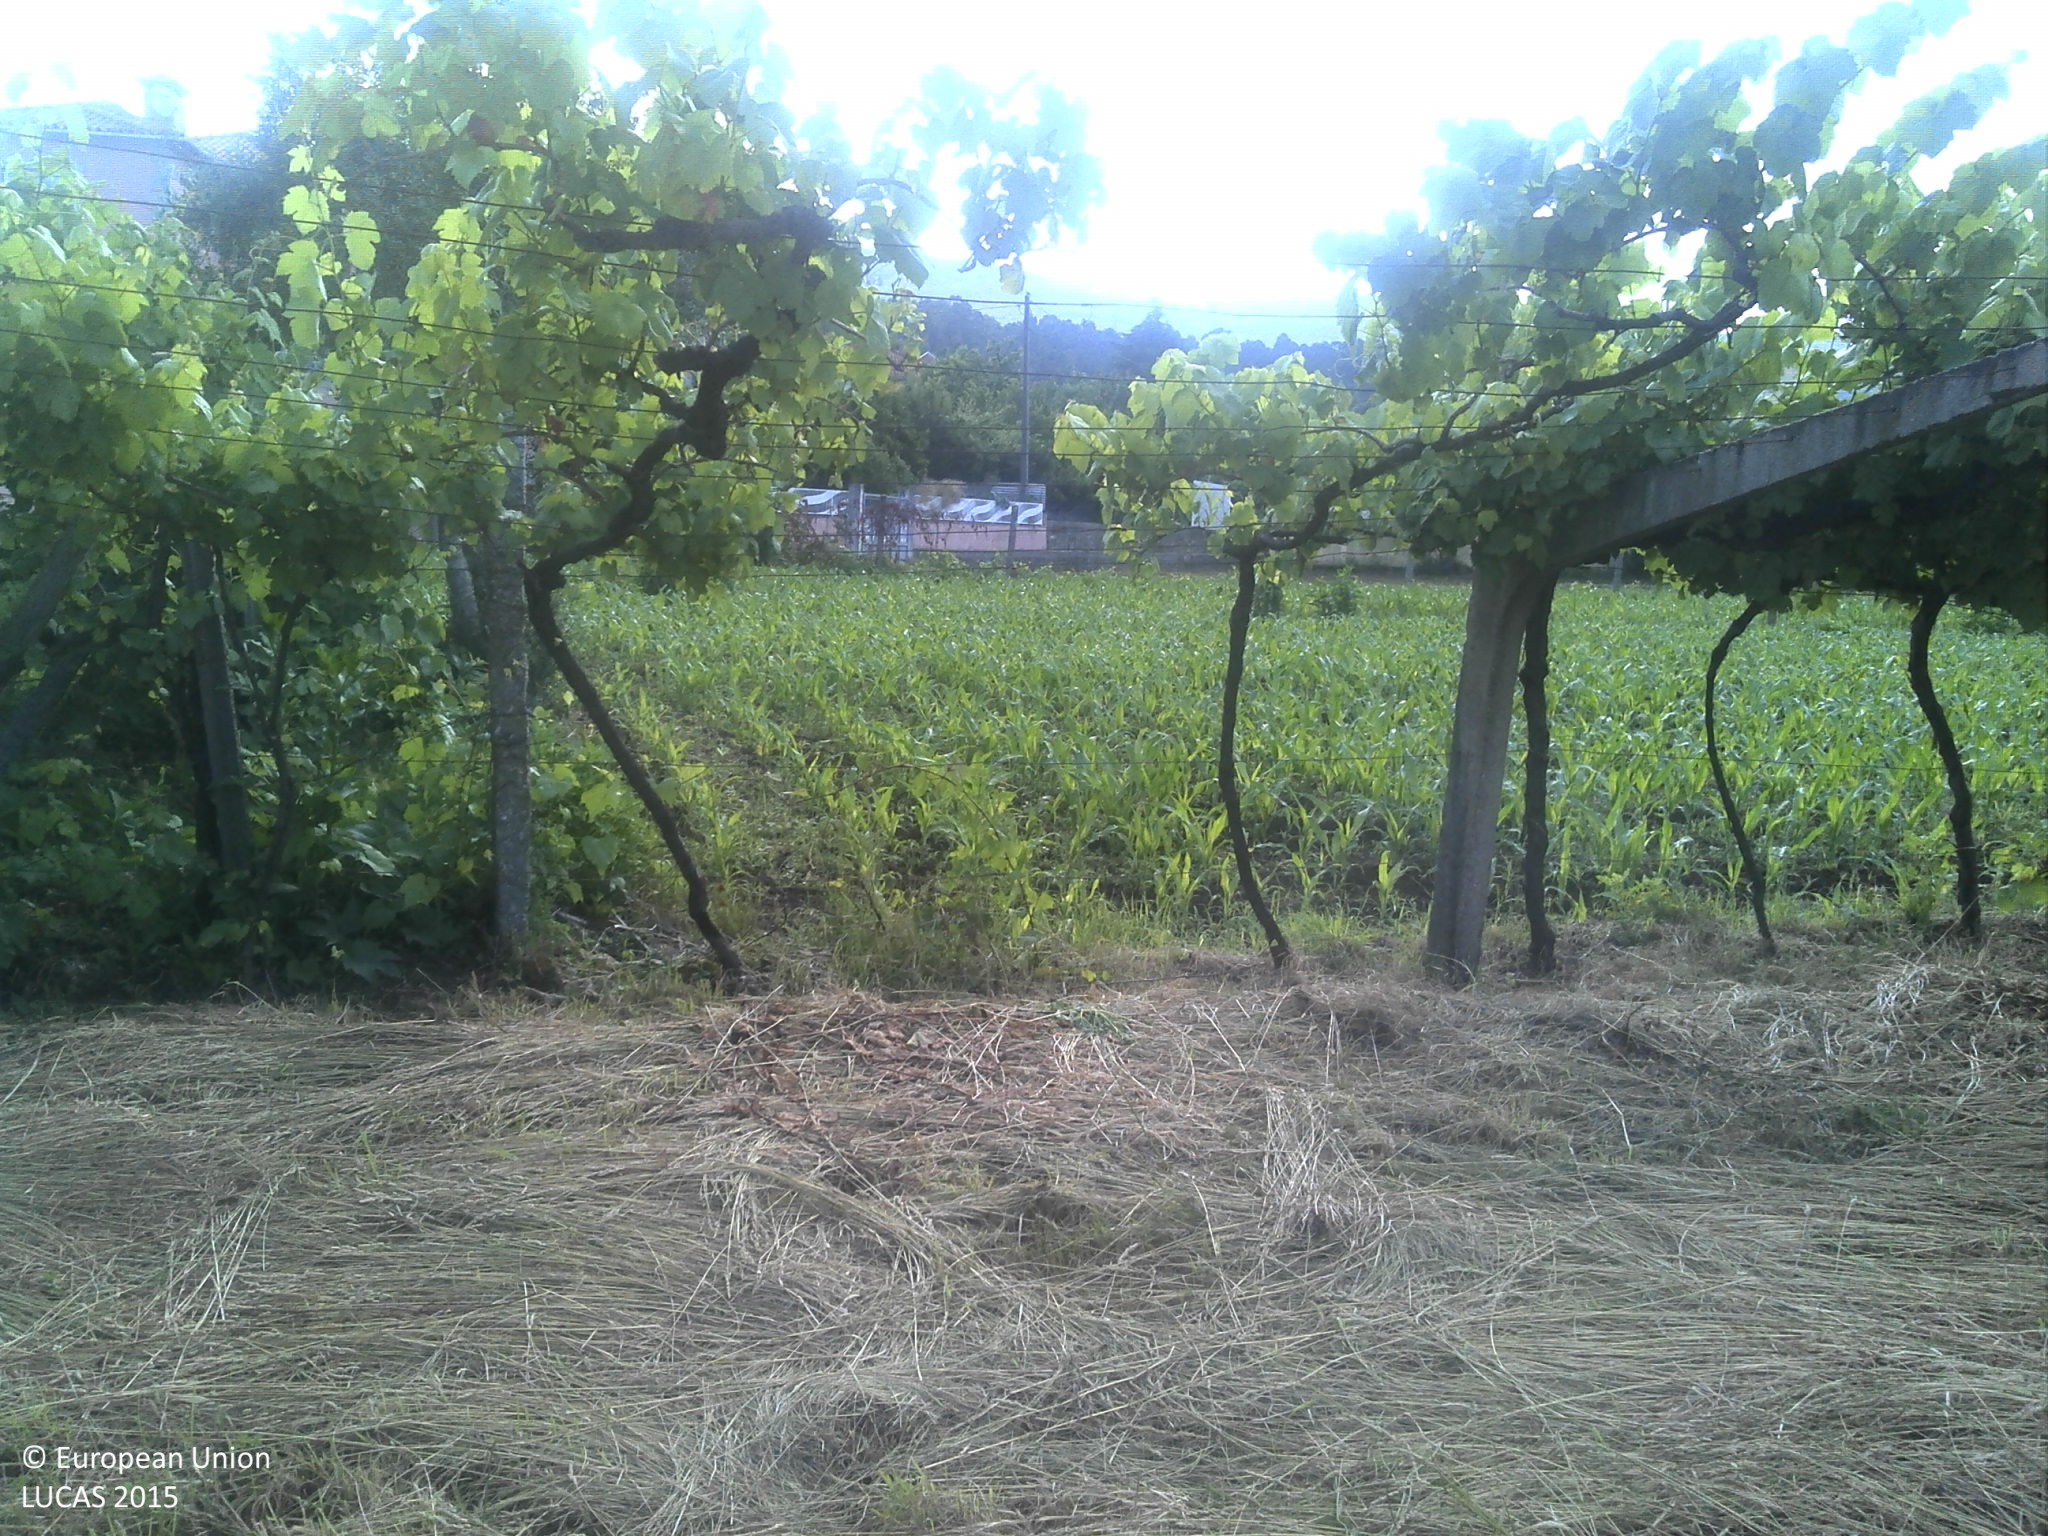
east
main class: Cropland
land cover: Temporary grasslands
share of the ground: 50 - 75 %
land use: Agriculture (excluding fallow land and kitchen gardens)
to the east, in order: Temporary grasslands; Vineyards; Maize; Vineyards; Maize; Dry stone walls; Tracks; Dry stone walls; Artificial constructions in urban areas; Other fruit trees and berries; Electric lines; Other fresh vegetables; Artificial constructions in urban areas; Other fruit trees and berries; Dry stone walls; Grassland without tree/shrub cover; Abandoned hedges; Maize; Dry stone walls; Spontaneously vegetated surfaces; Dry stone walls; Electric lines; Paved roads, cycling and walking lanes; Dry stone walls; Other fresh vegetables; Vineyards
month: June
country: PT
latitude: 41.6142
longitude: -8.7042
